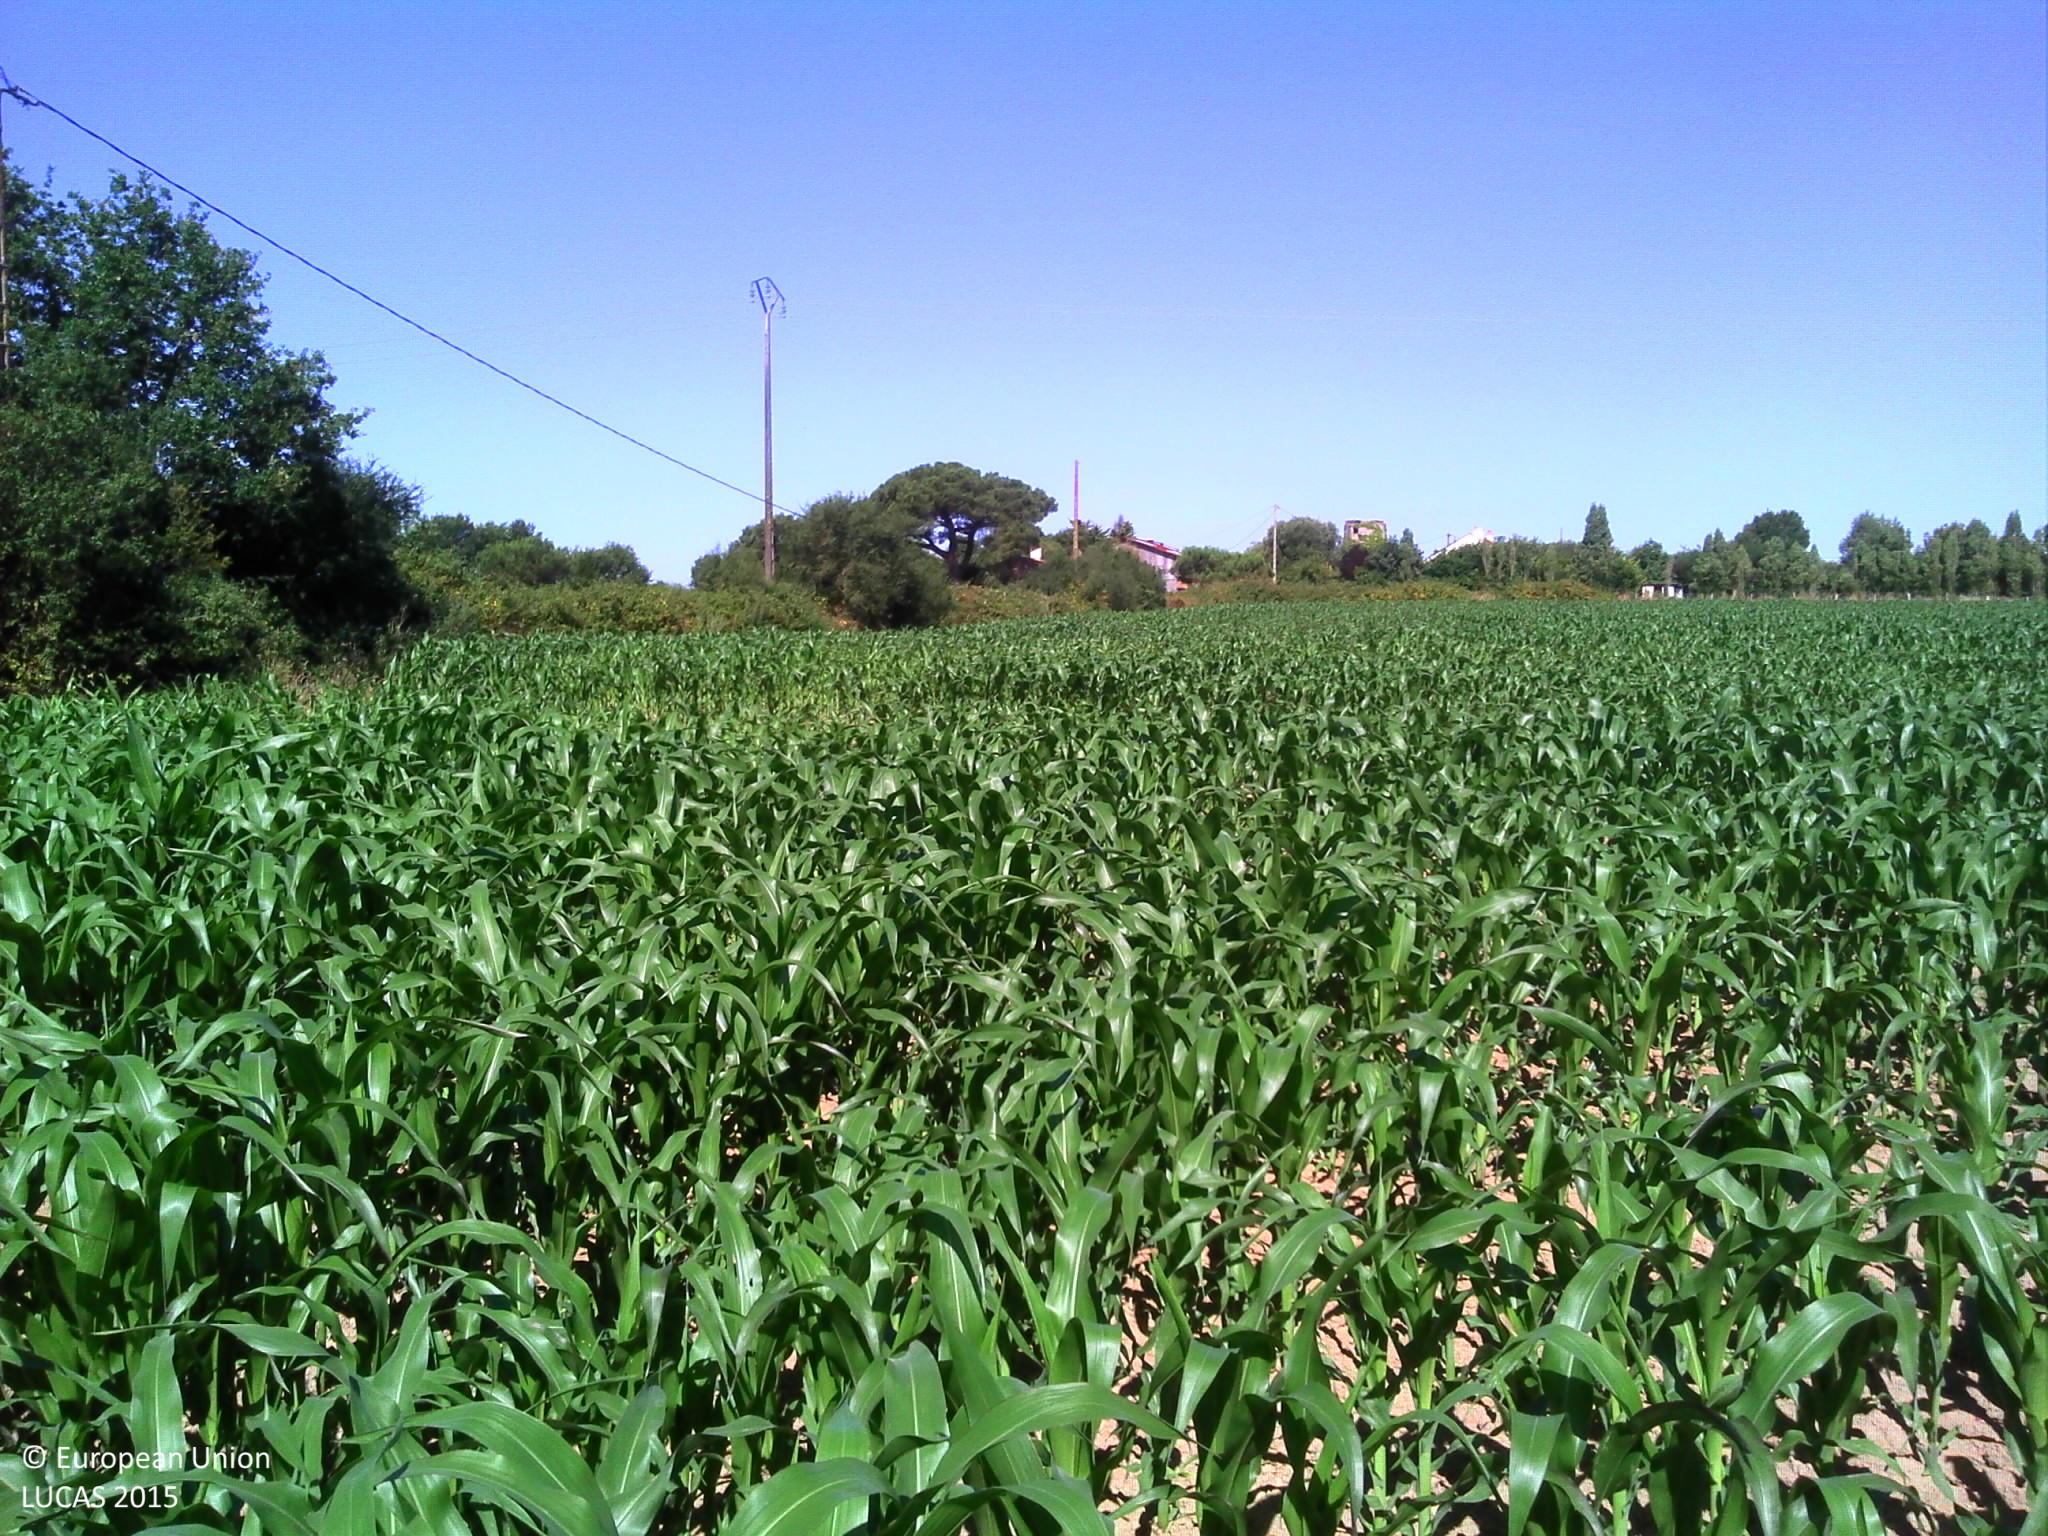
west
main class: Cropland
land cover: Maize
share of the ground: 50 - 75 %
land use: Agriculture (excluding fallow land and kitchen gardens)
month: July
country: FR
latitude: 47.1513
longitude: -1.7958
